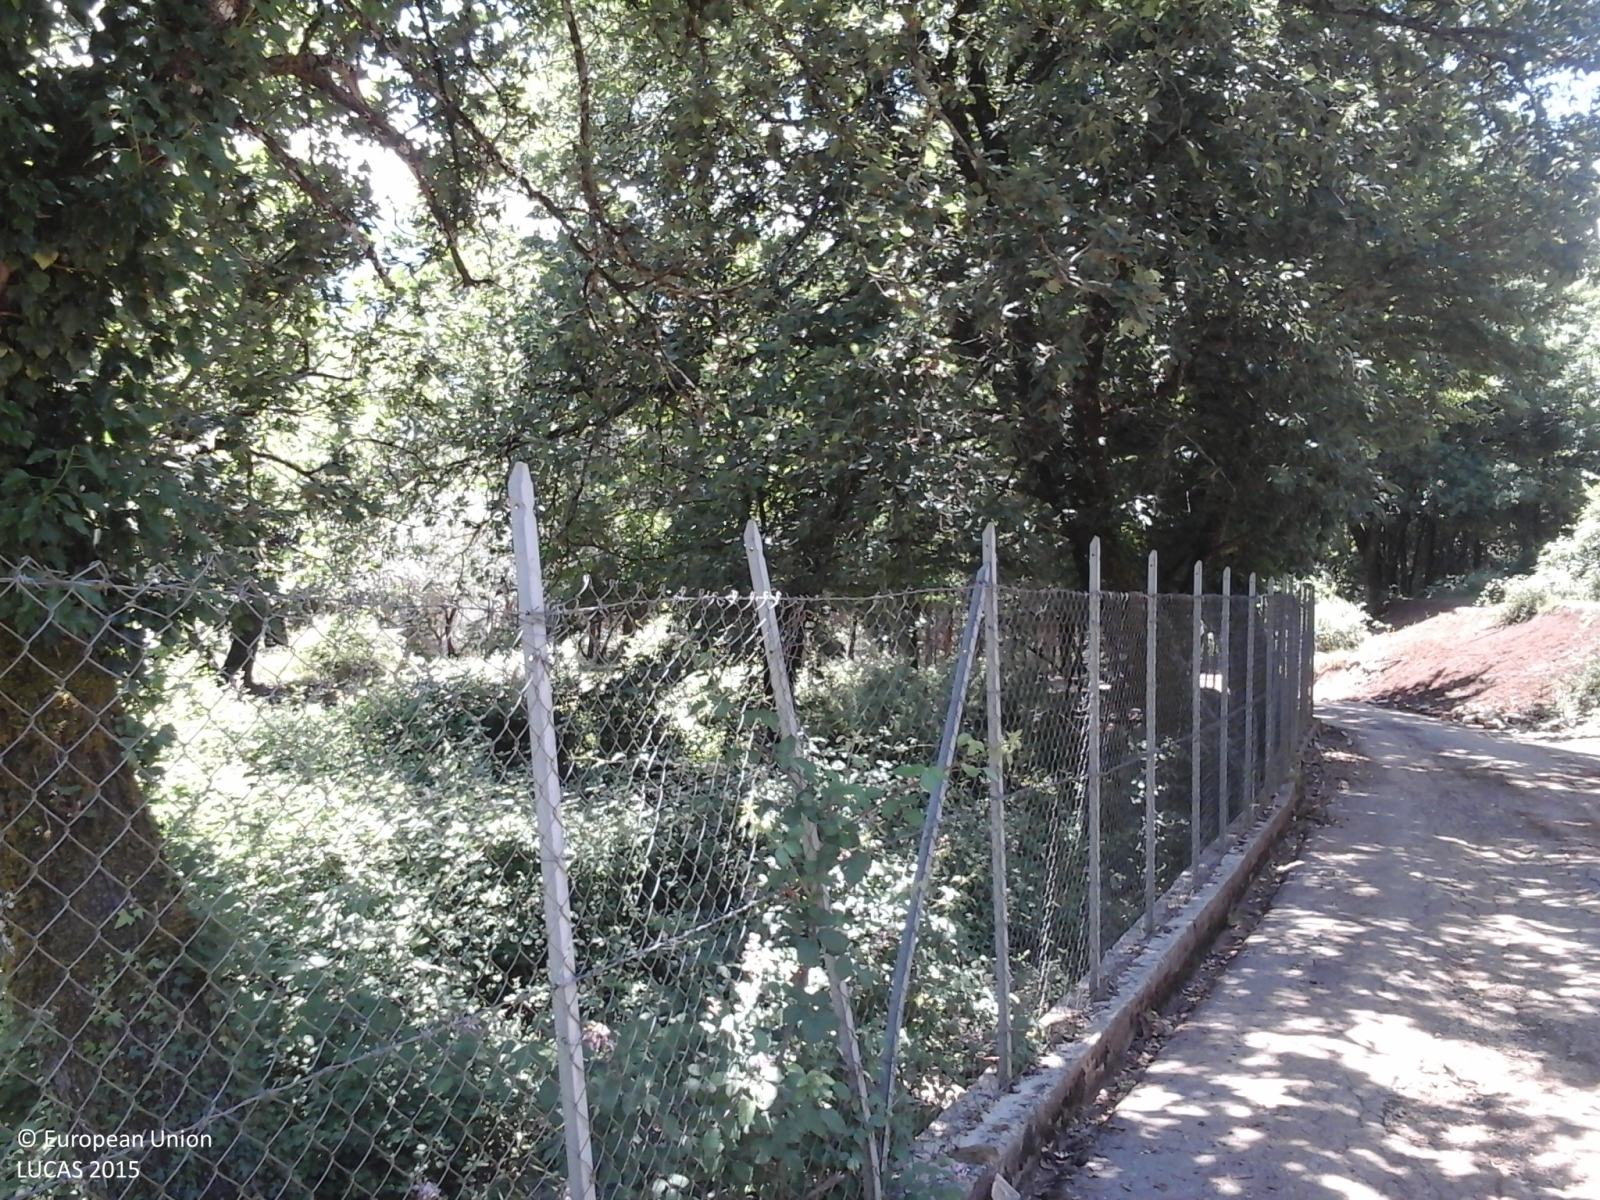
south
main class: Woodland
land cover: Broadleaved woodland
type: thermophilous deciduous forest
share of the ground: > 75 %
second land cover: Grassland without tree/shrub cover
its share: > 75 %
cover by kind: broadleaved forest trees 70 %, herbaceous plants 30 %
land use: Forestry
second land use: Agriculture (excluding fallow land and kitchen gardens)
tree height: > 5 m
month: June
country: IT
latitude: 41.6311
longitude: 13.0732
